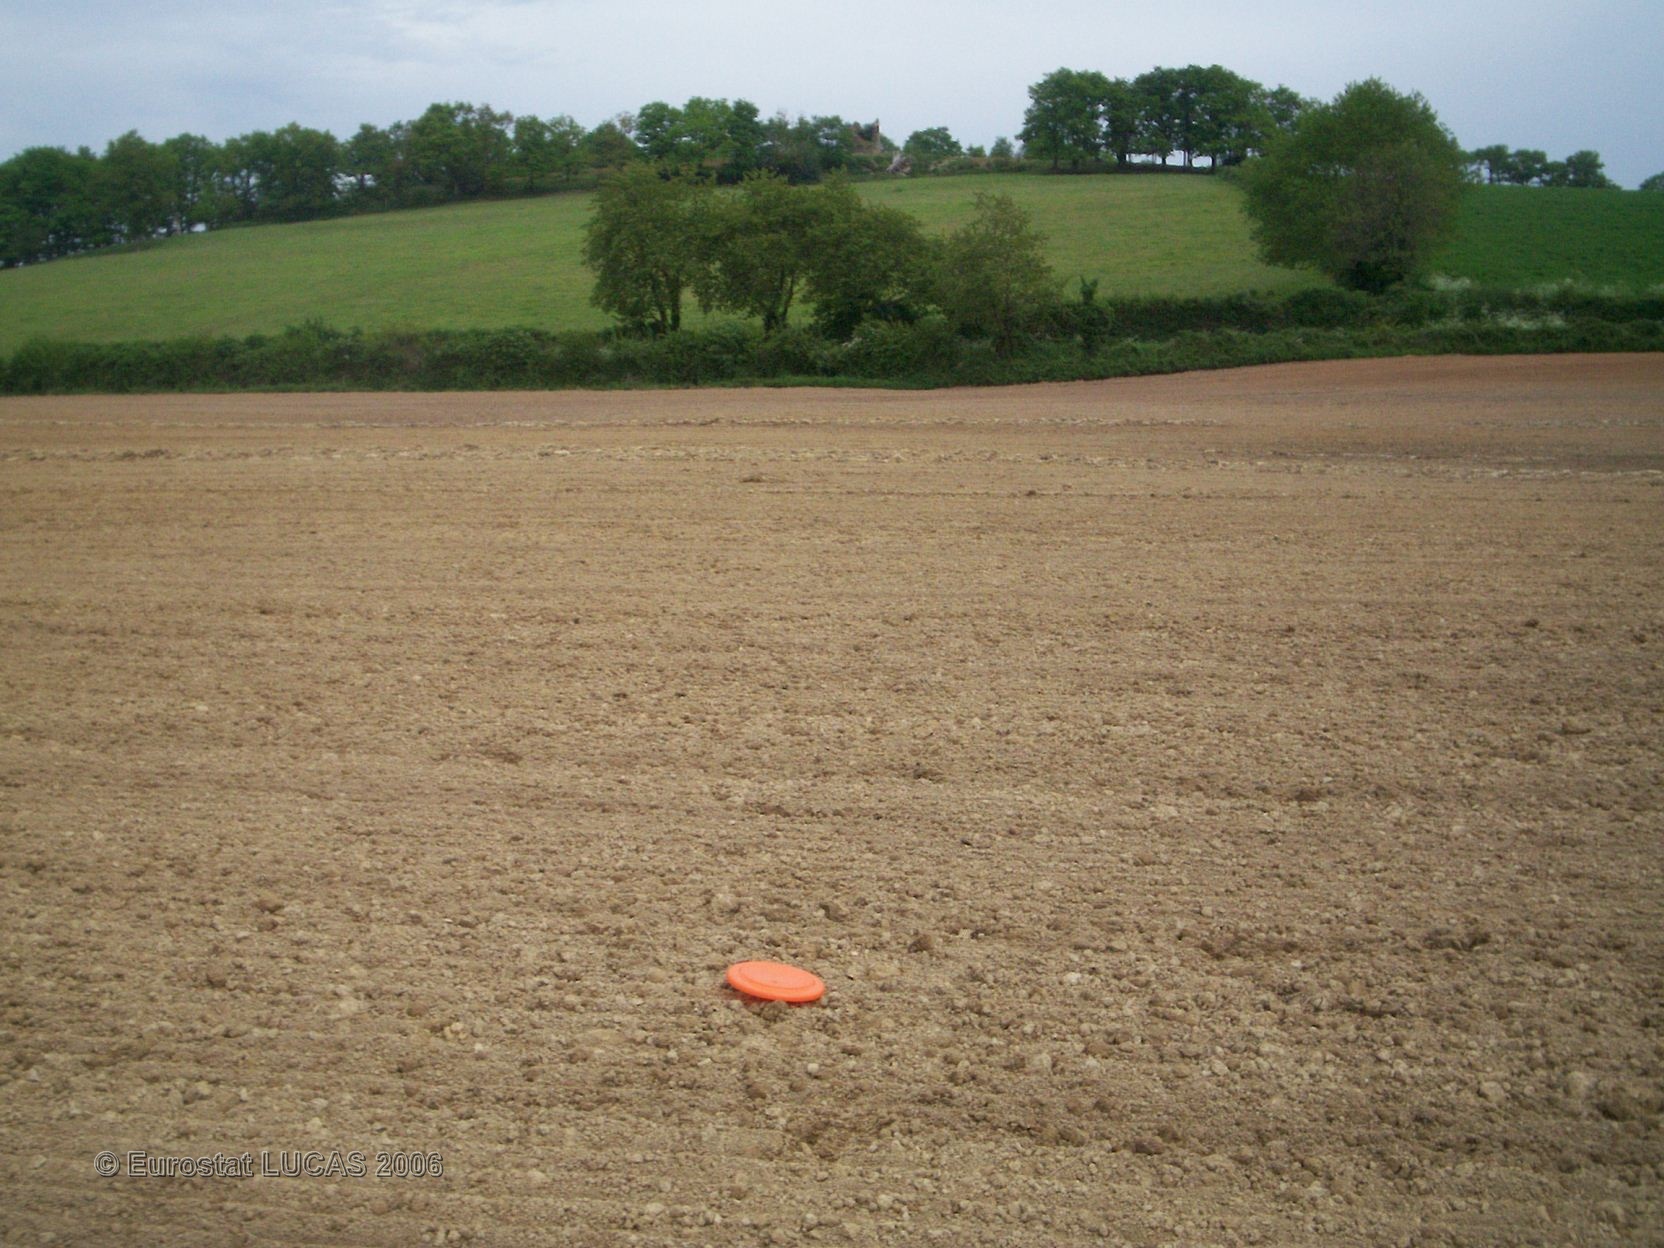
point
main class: Cropland
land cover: Maize
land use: Agriculture (excluding fallow land and kitchen gardens)
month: May
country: FR
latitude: 46.7264
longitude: -0.8258
